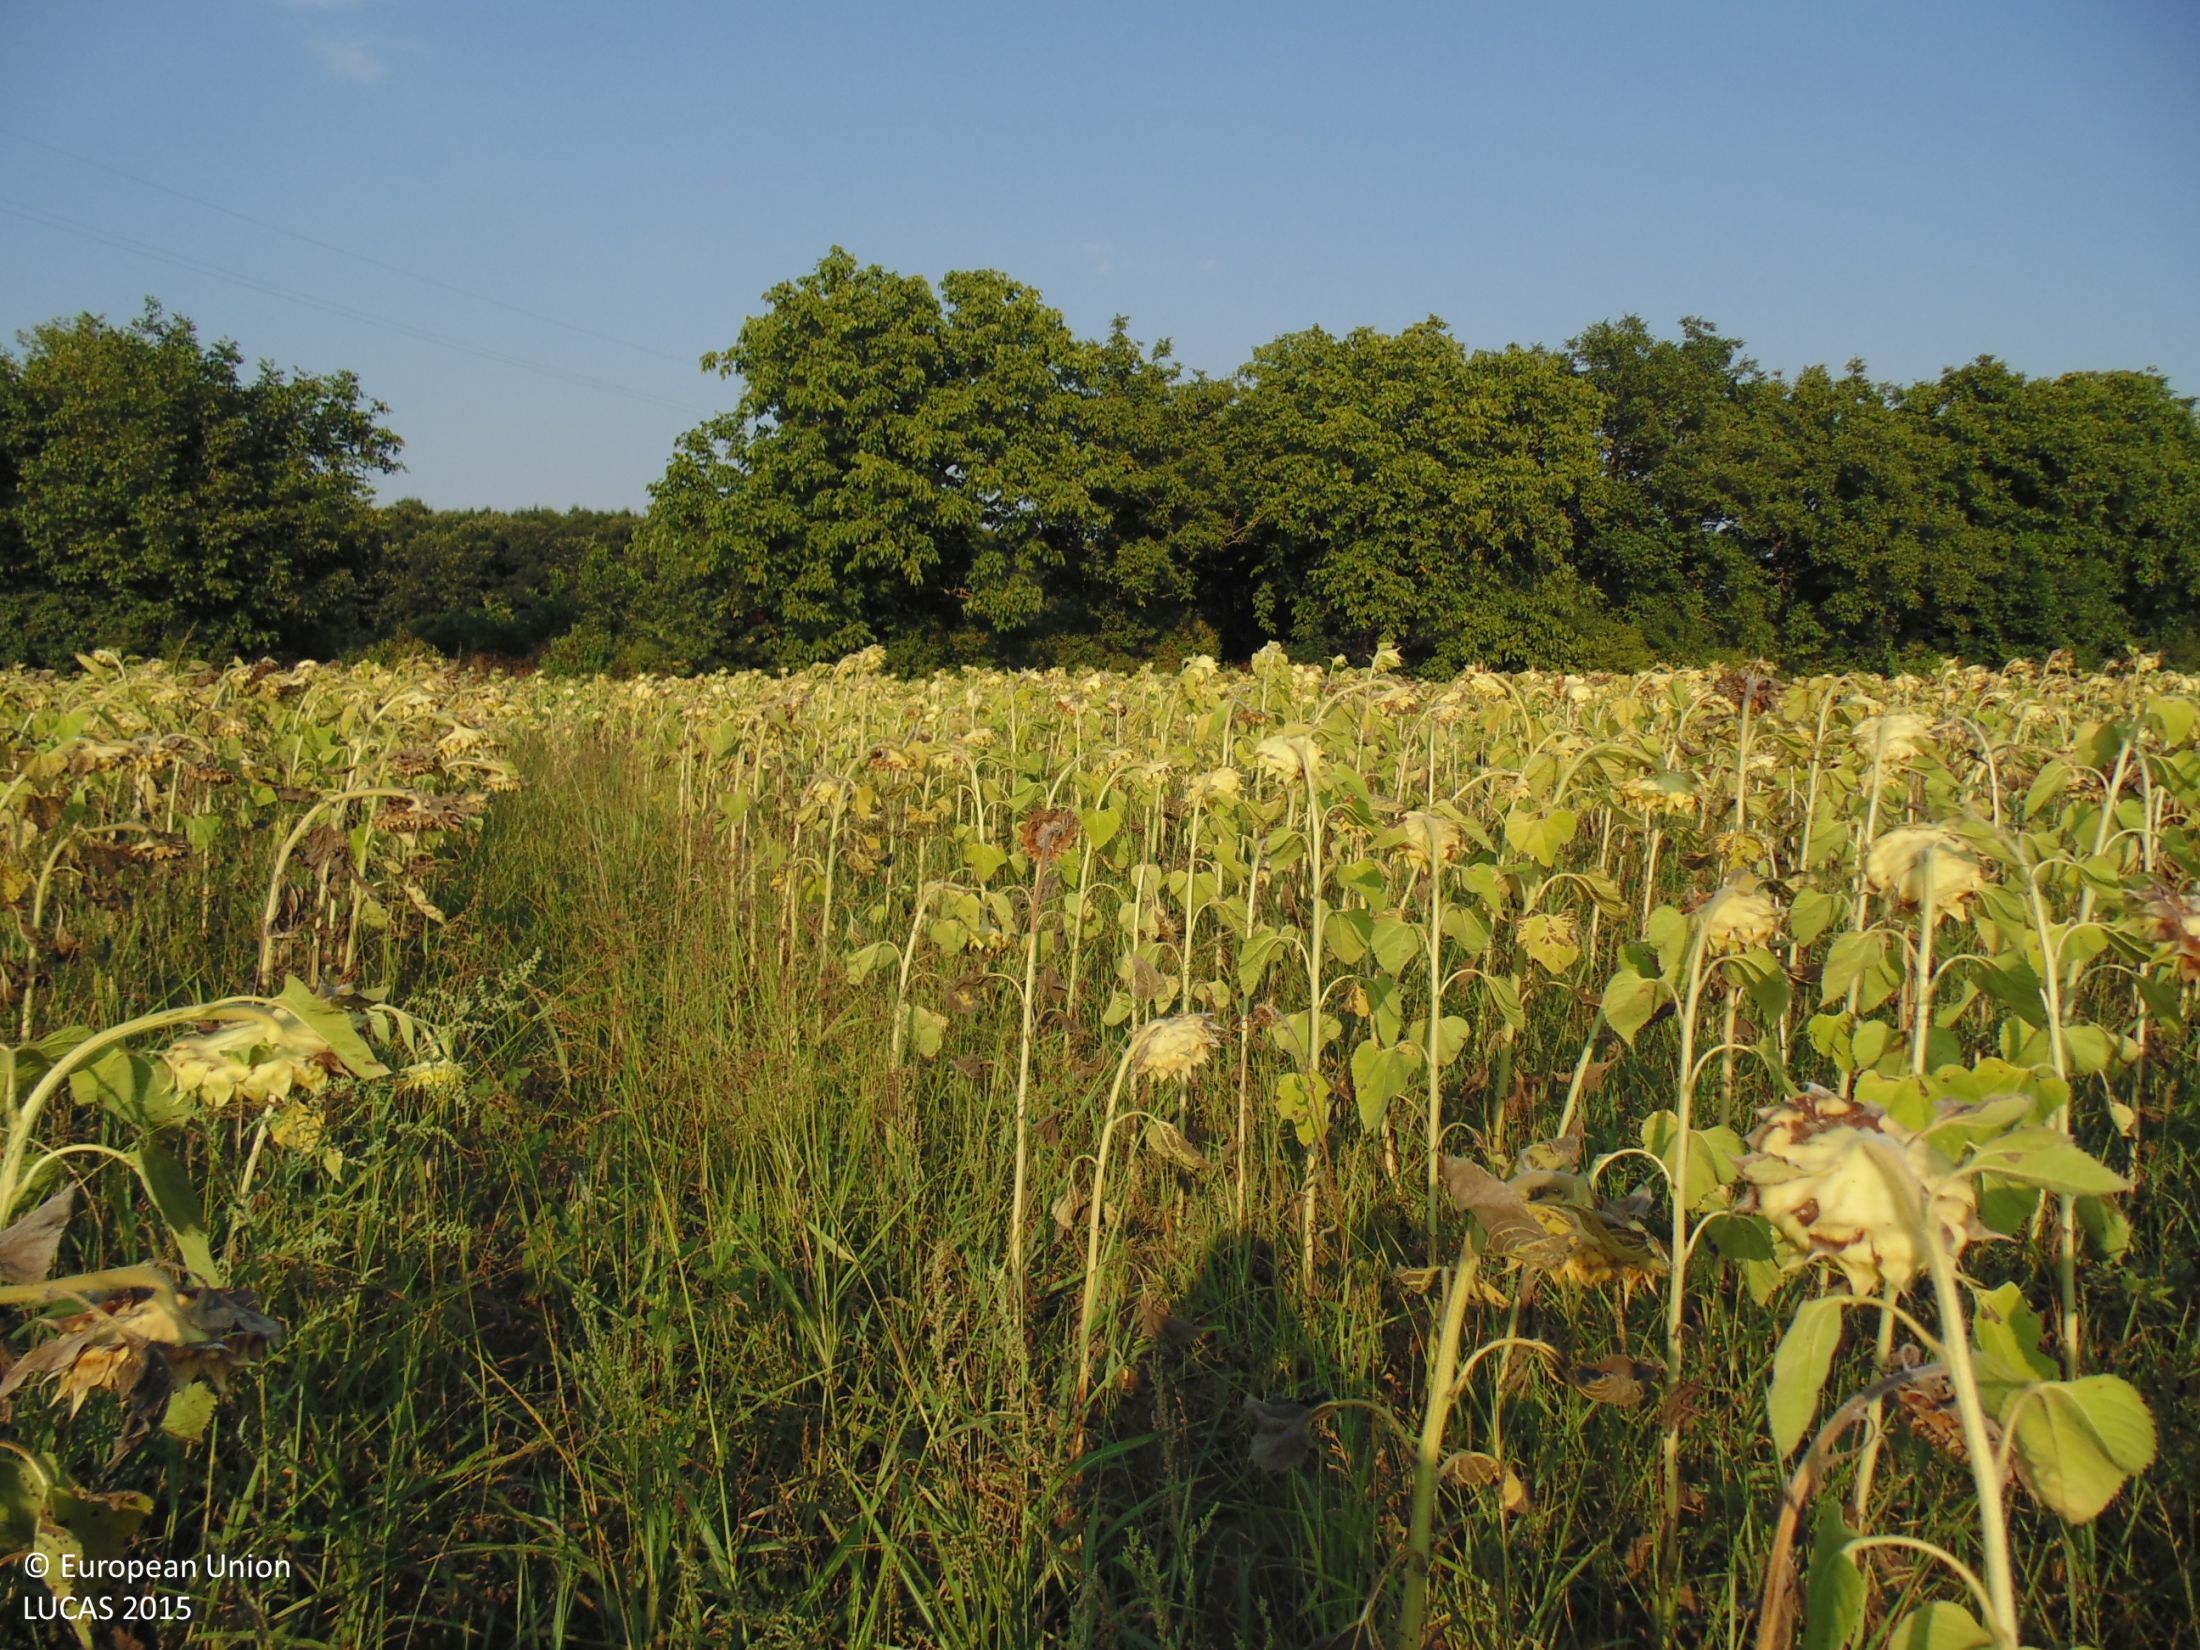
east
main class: Cropland
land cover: Sunflower
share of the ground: > 75 %
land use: Agriculture (excluding fallow land and kitchen gardens)
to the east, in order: Sunflower; Grassland with sparse tree/shrub cover; Sunflower; Grass margins; Lines of trees; Grass margins; Paved roads, cycling and walking lanes; Grass margins; Lines of trees; Grass margins; Other fresh vegetables
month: August
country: BG
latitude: 43.8538
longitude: 27.3358
